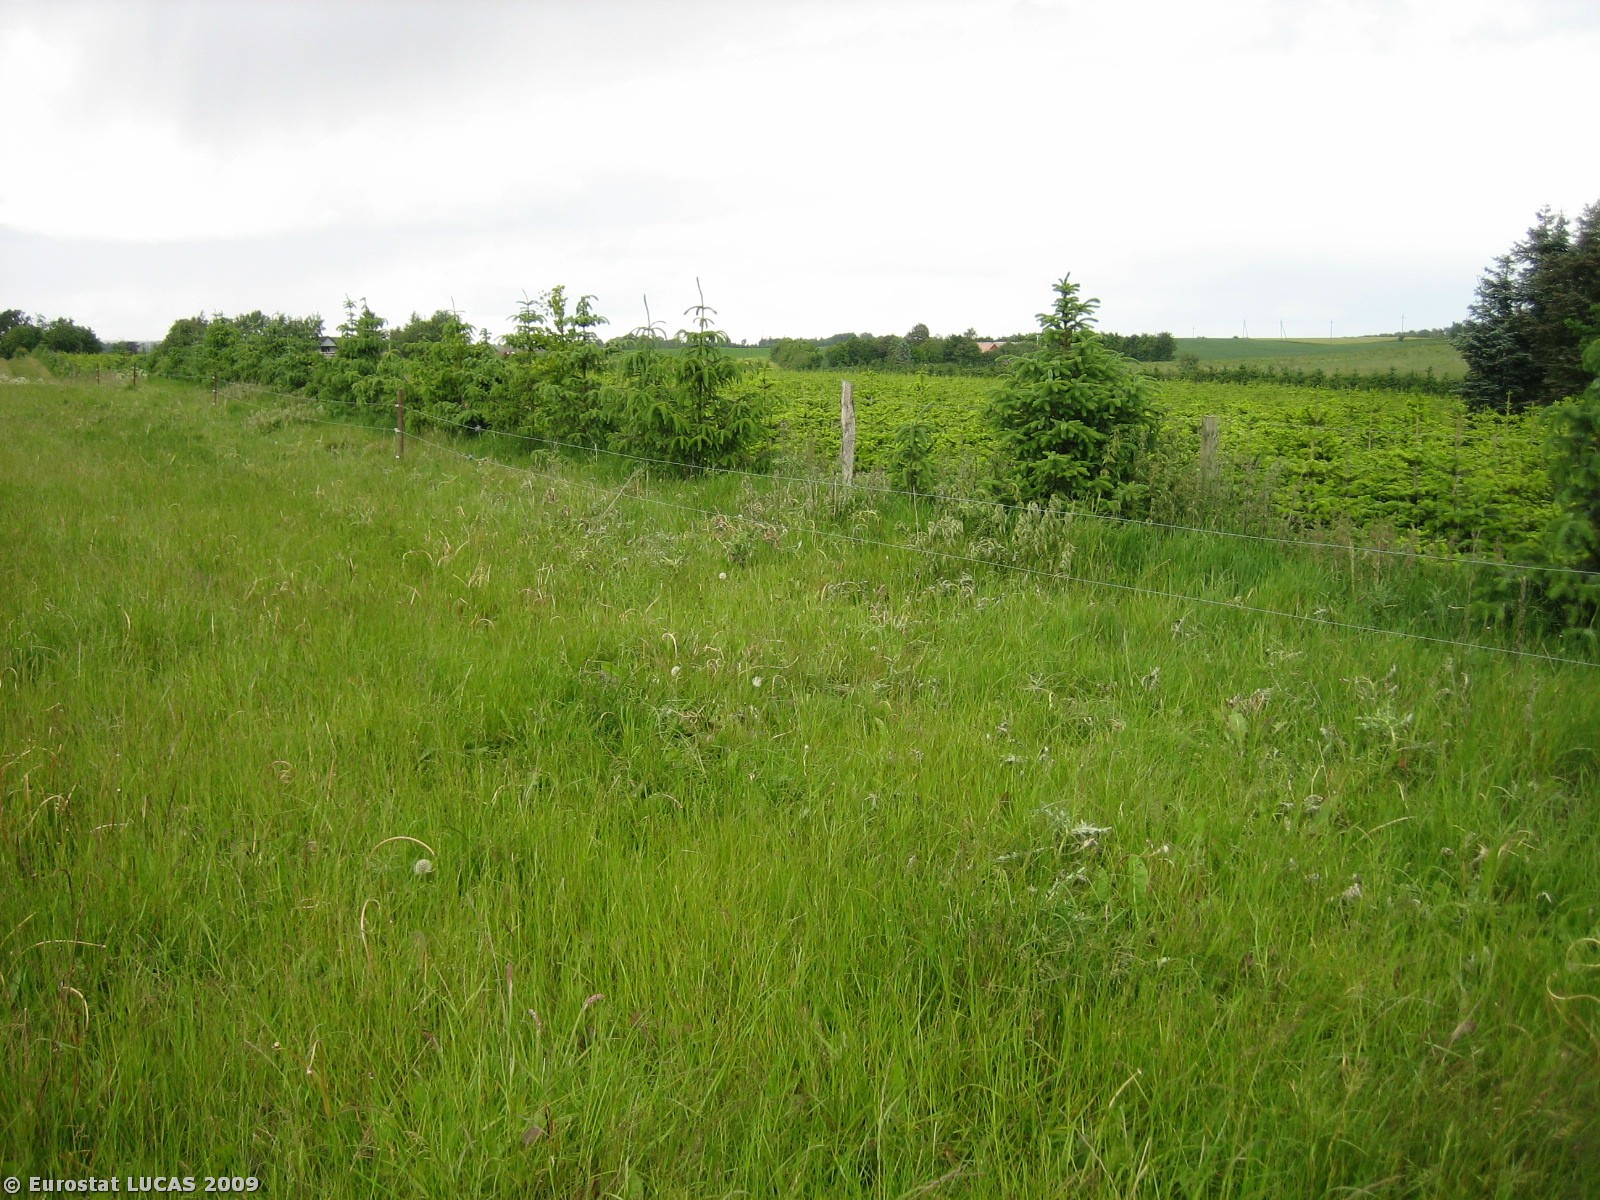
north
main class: Grassland
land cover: Grassland without tree/shrub cover
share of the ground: > 75 %
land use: Agriculture (excluding fallow land and kitchen gardens)
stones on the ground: < 10 %
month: June
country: DK
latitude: 56.2775
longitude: 9.8548
